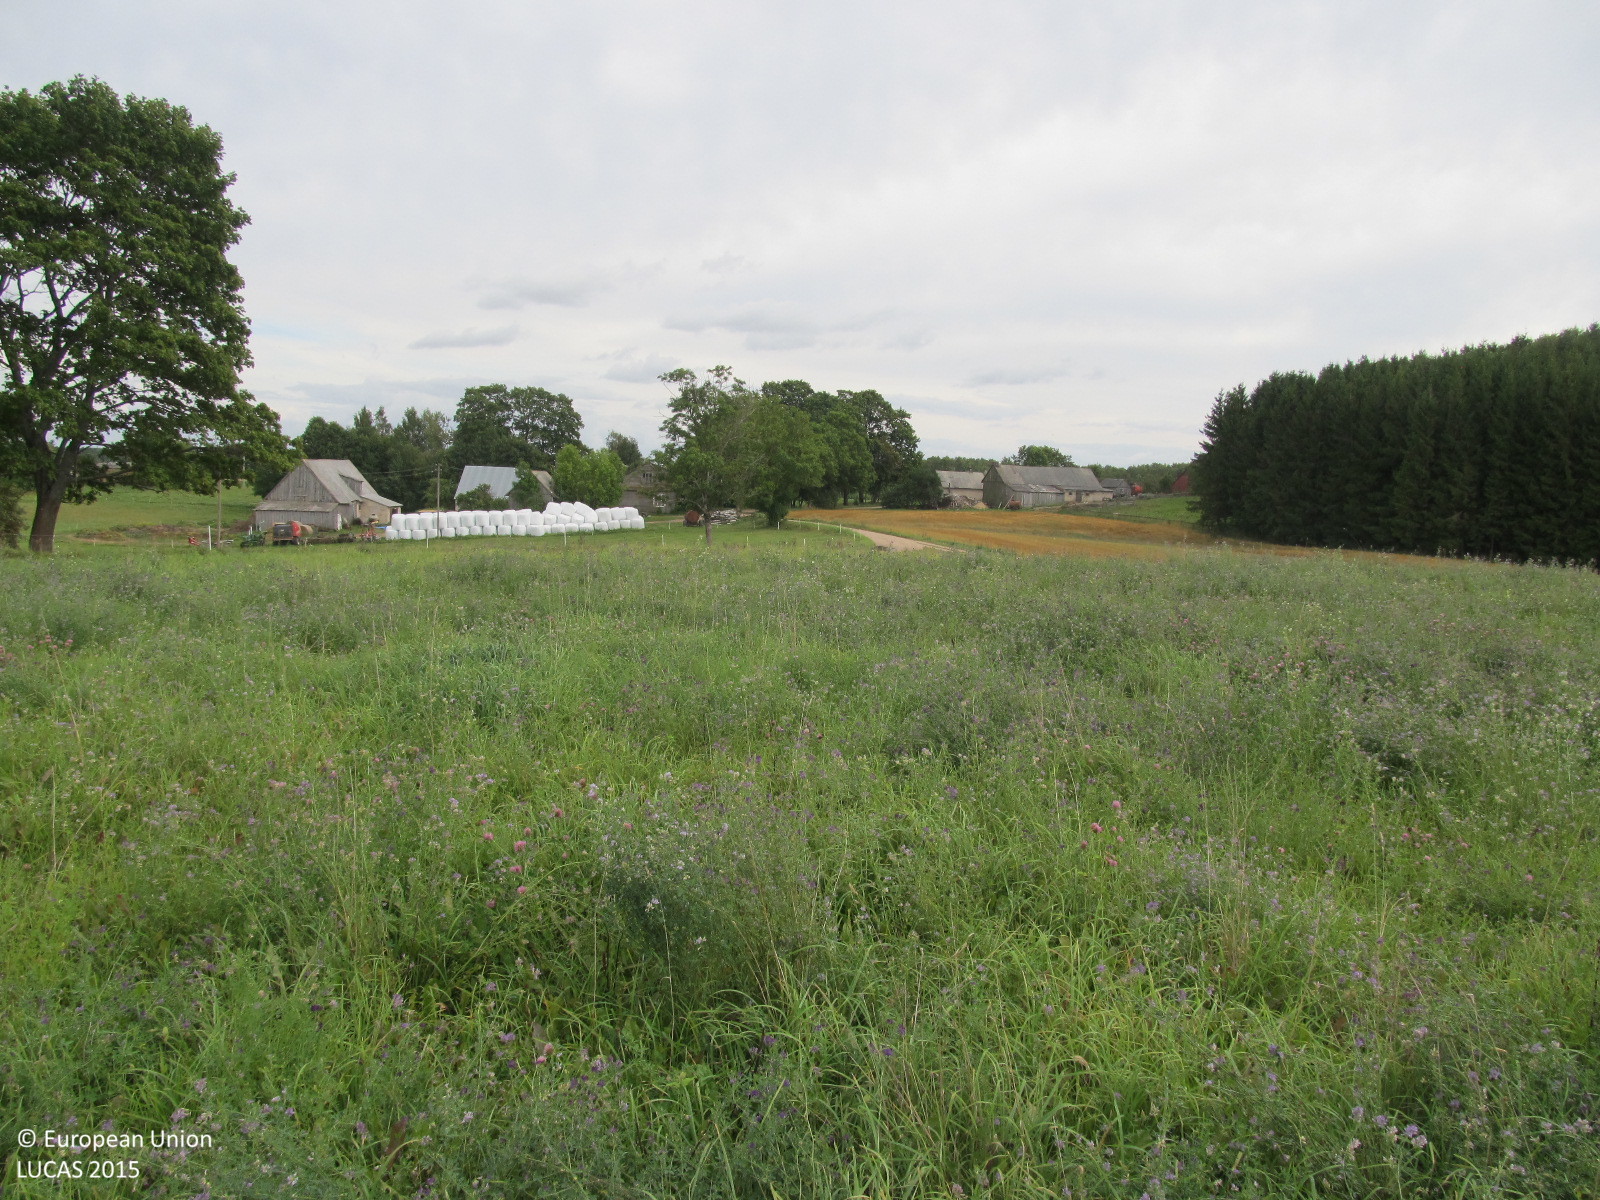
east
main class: Grassland
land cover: Grassland without tree/shrub cover
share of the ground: > 75 %
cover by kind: herbaceous plants 100 %
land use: Agriculture (excluding fallow land and kitchen gardens)
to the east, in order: Grassland without tree/shrub cover; Paved roads, cycling and walking lanes; Grass margins; Fences; Grassland without tree/shrub cover; Single bushes/trees; Grass margins; Fences; Grassland without tree/shrub cover; Fences; Grassland with sparse tree/shrub cover; Paved roads, cycling and walking lanes; Lines of trees; Fences; Grassland without tree/shrub cover; Fences; Broadleaved woodland; Grassland without tree/shrub cover
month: September
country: LT
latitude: 55.7043
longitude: 22.6502
